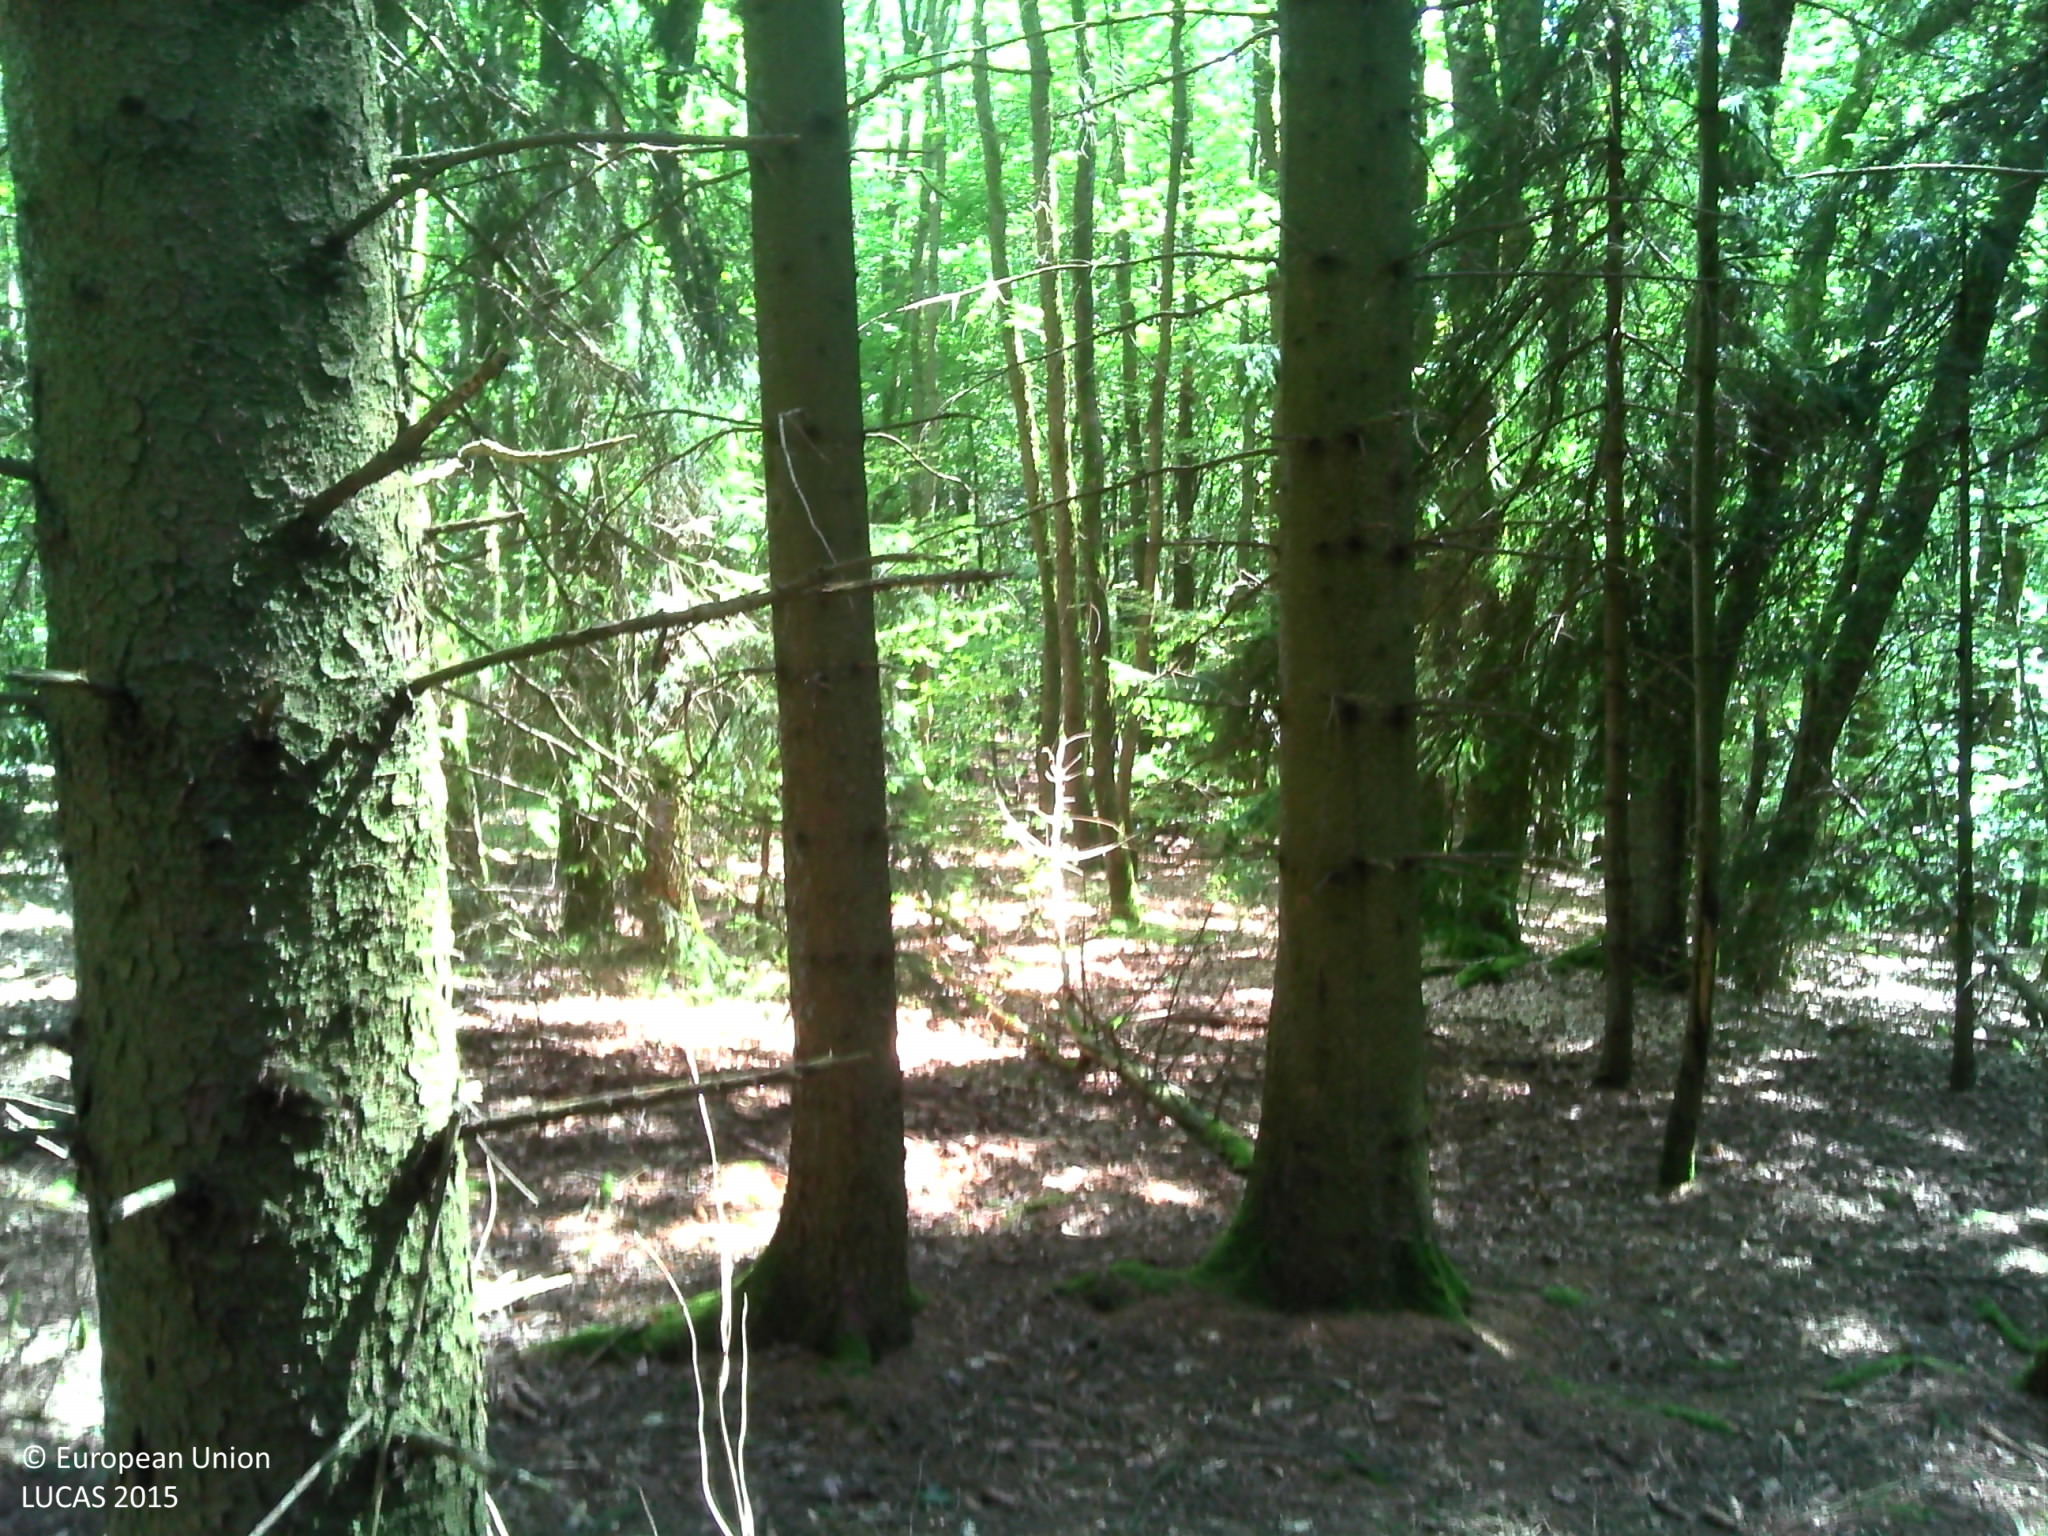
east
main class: Woodland
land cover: Spruce dominated coniferous woodland
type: exotic forest
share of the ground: > 75 %
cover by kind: coniferous forest trees 95 %, broadleaved forest trees 5 %
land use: Forestry
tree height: > 5 m
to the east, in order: Spruce dominated coniferous woodland; Tracks; Broadleaved woodland; Spruce dominated coniferous woodland; Tracks; Broadleaved woodland; Tracks; Spruce dominated coniferous woodland; Broadleaved woodland; Spruce dominated coniferous woodland; Broadleaved woodland
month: August
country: LU
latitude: 49.8214
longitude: 5.8708
